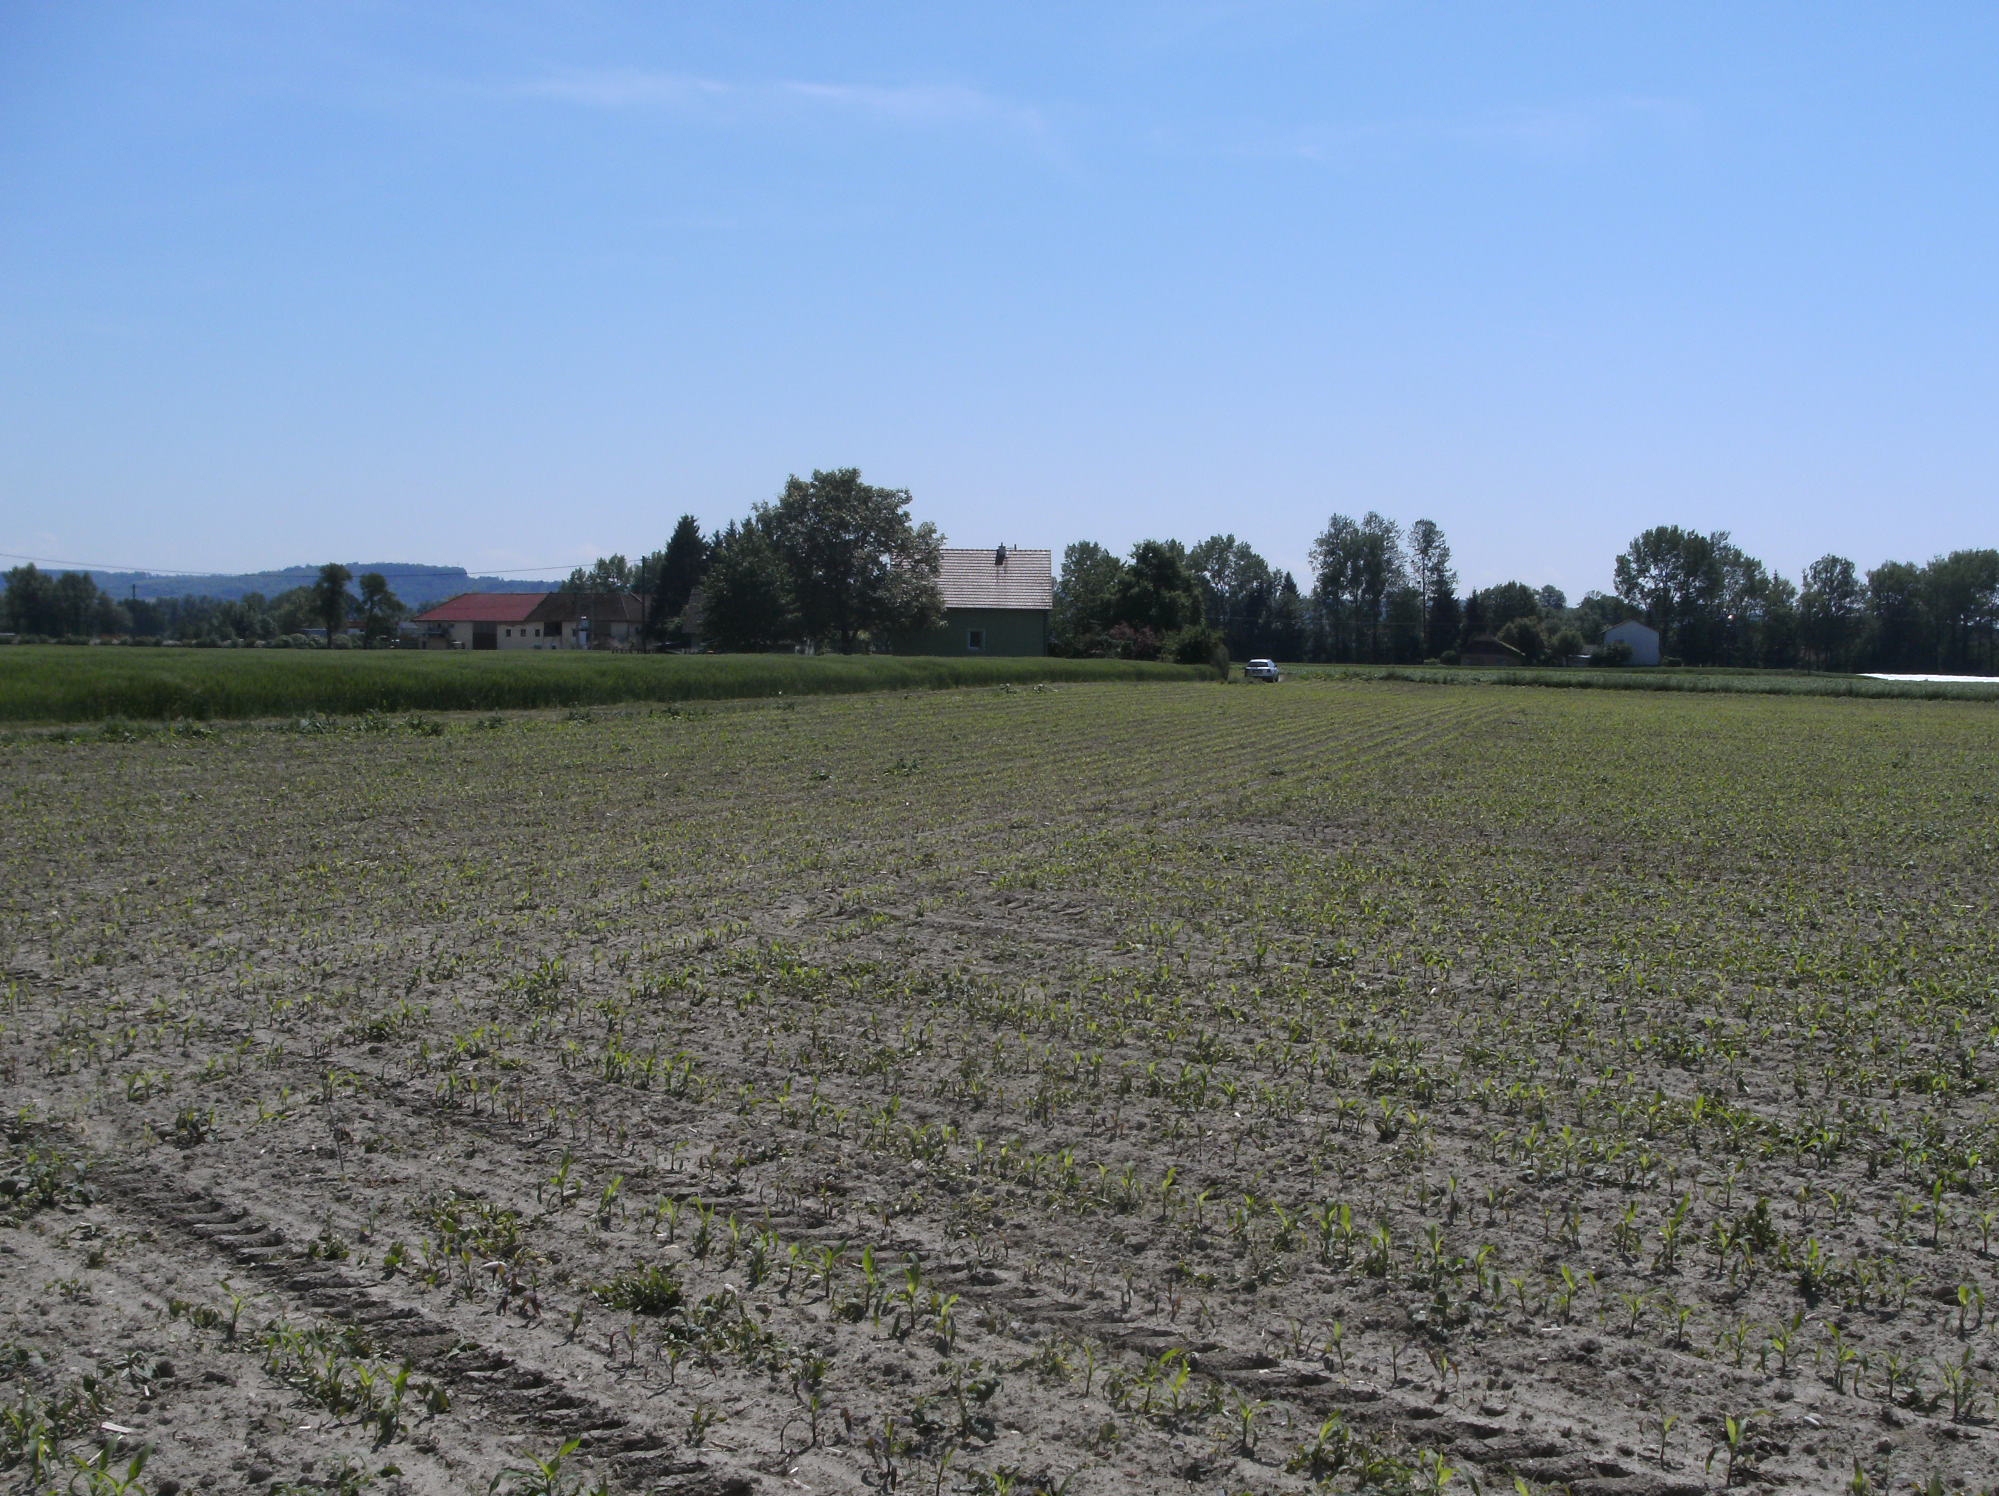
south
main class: Cropland
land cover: Maize
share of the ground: 10 - 25 %
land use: Agriculture (excluding fallow land and kitchen gardens)
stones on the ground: < 10 %
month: May
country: AT
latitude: 48.3120
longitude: 14.0315
